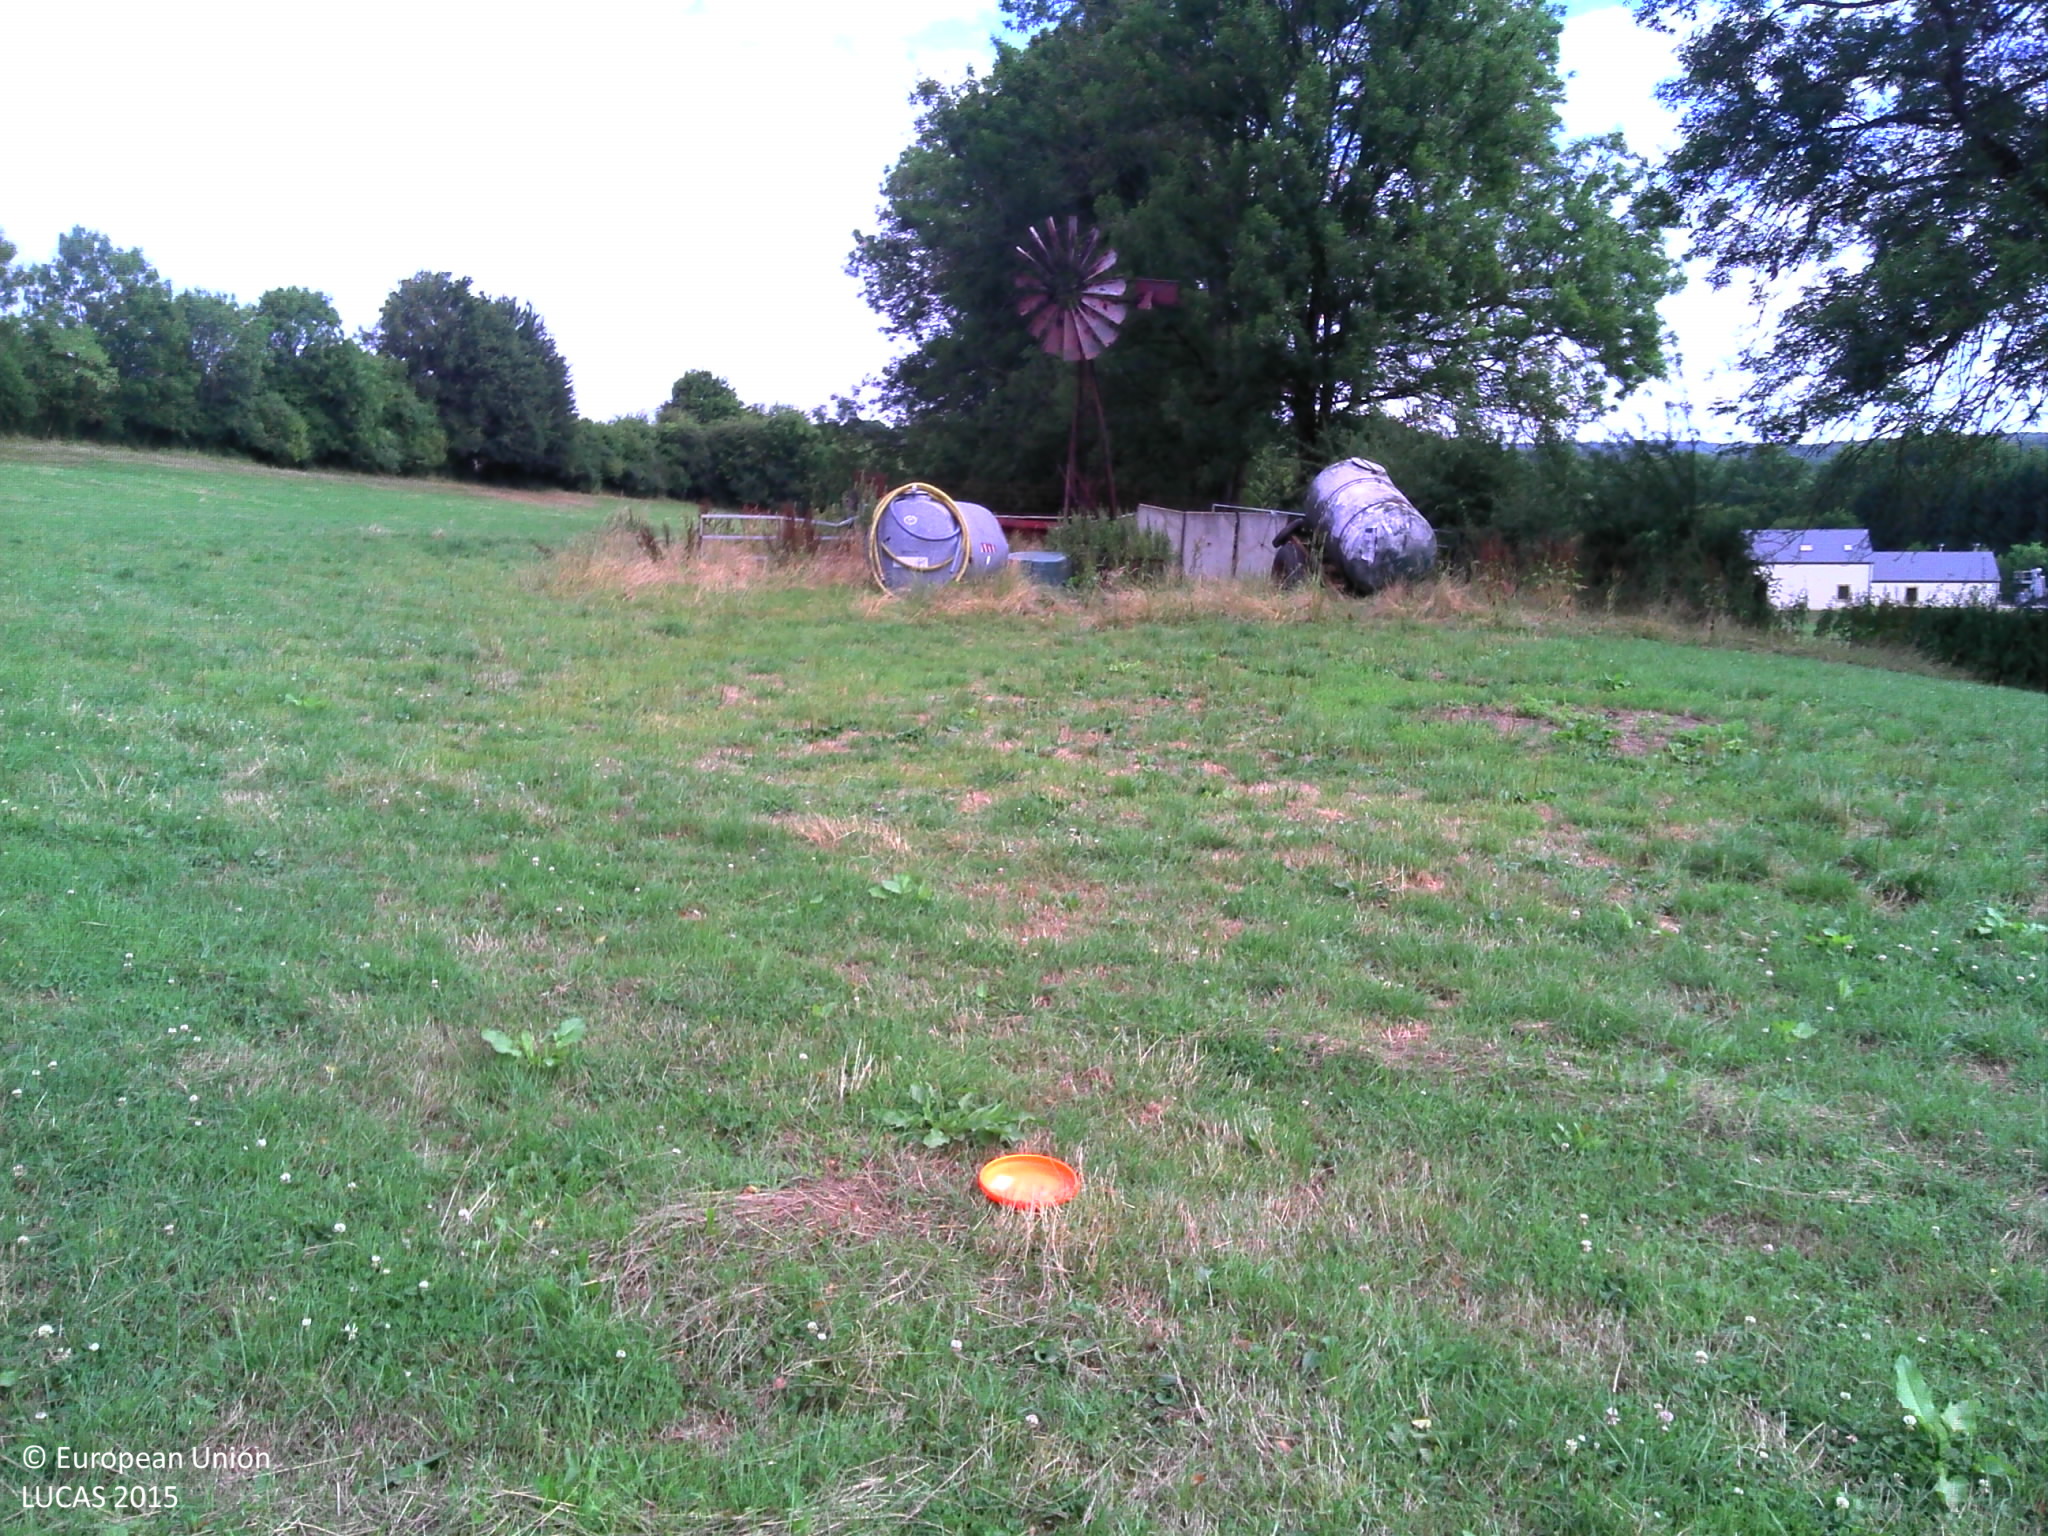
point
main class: Grassland
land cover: Grassland without tree/shrub cover
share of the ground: > 75 %
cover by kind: herbaceous plants 100 %
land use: Agriculture (excluding fallow land and kitchen gardens)
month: July
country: BE
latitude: 49.7090
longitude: 5.2970
